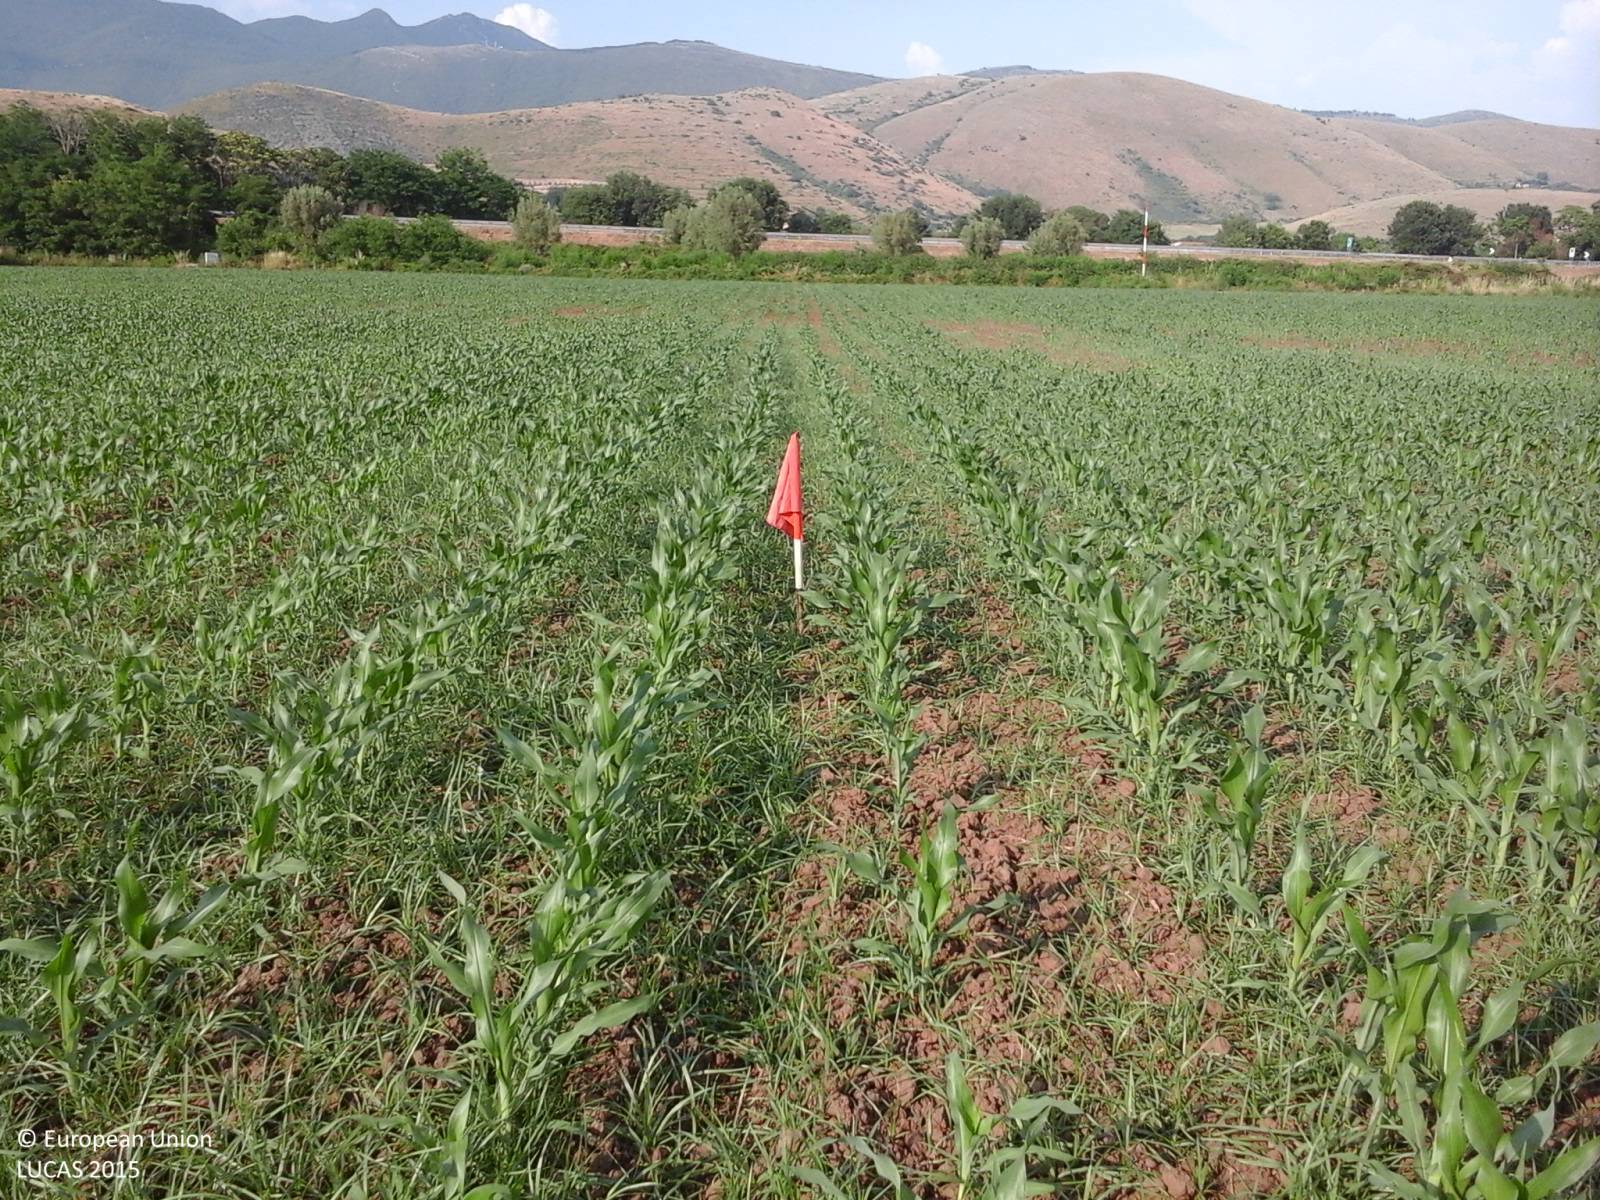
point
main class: Cropland
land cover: Maize
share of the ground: 25 - 50 %
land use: Agriculture (excluding fallow land and kitchen gardens)
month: June
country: IT
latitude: 41.1941
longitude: 14.1450
